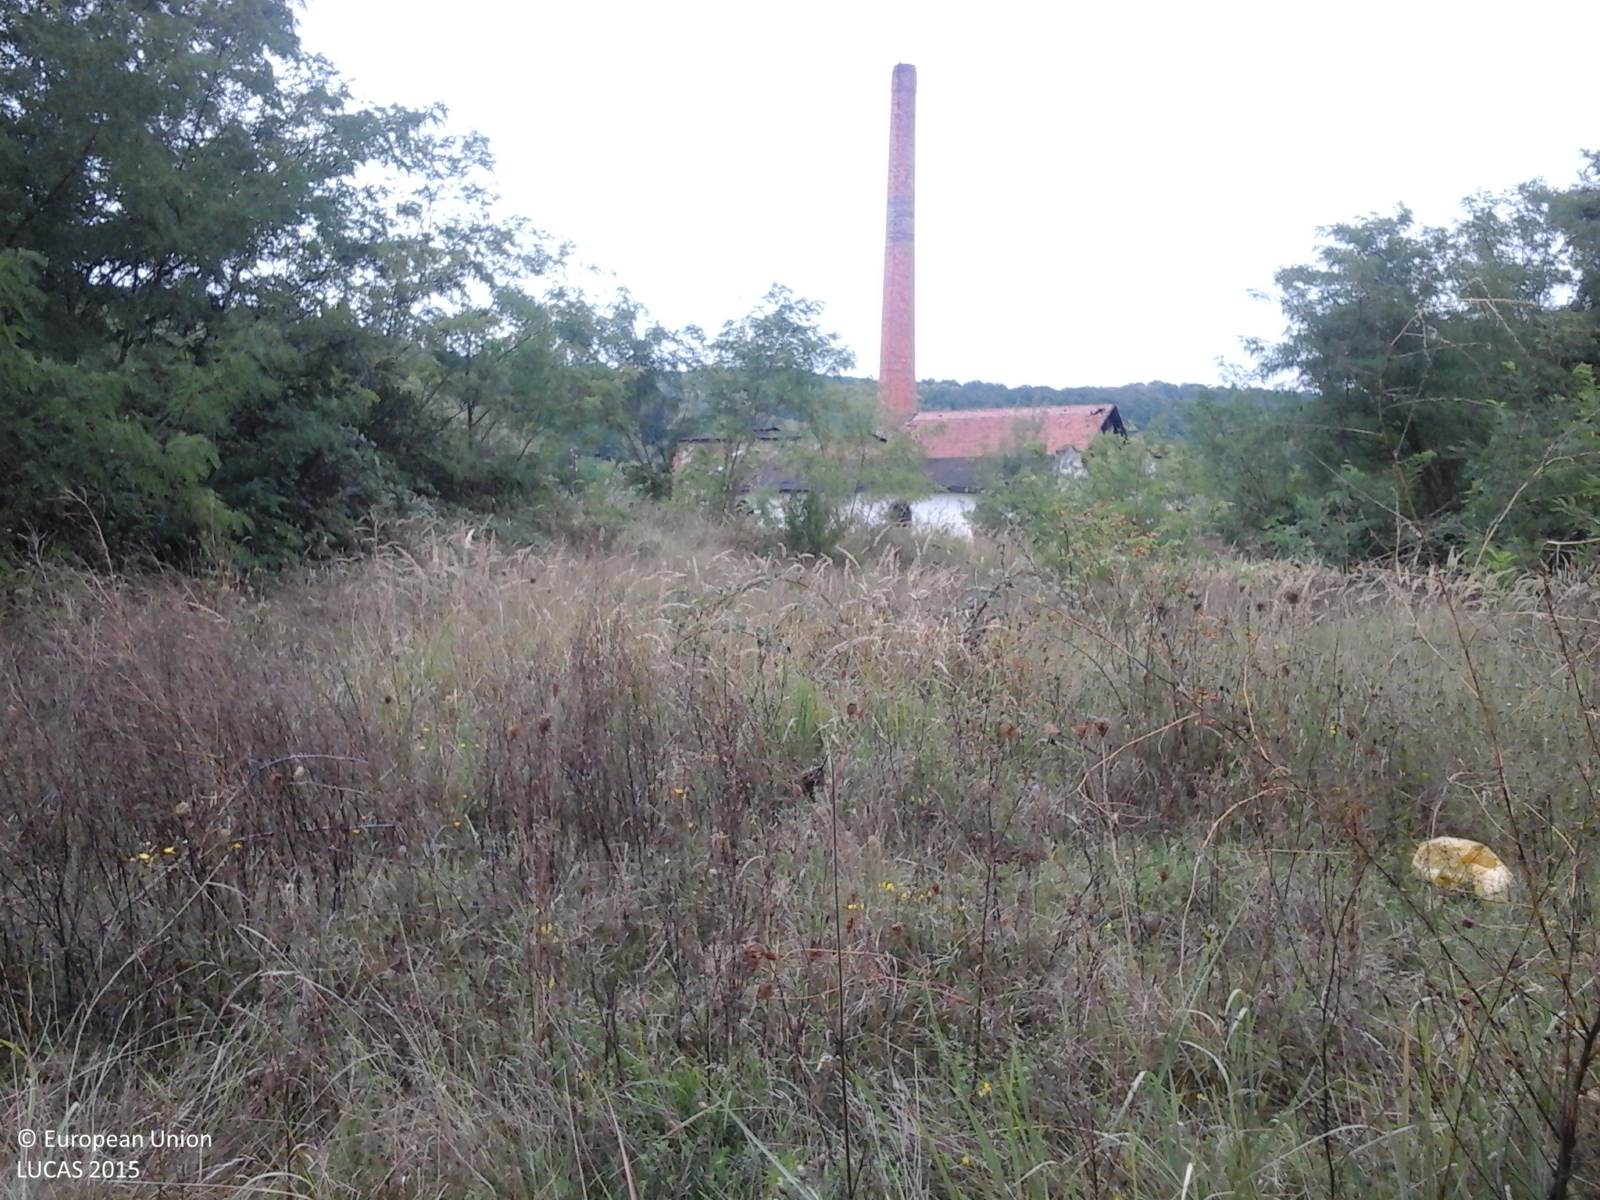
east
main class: Grassland
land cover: Grassland with sparse tree/shrub cover
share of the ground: > 75 %
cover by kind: herbaceous plants 85 %, shrubs 10 %, broadleaved forest trees 5 %
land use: Fallow land
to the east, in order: Grassland with sparse tree/shrub cover; Lines of trees; Inland fresh water bodies; Spontaneously vegetated surfaces; Ditches and canals; Grassland without tree/shrub cover; Tracks; Grassland without tree/shrub cover; Artificial constructions in urban areas; Shrubland with sparse tree cover; Tracks; Grass margins; Ditches and canals; Grassland without tree/shrub cover; Electric lines; Grassland without tree/shrub cover; Fences; Grass margins; Ditches and canals; Grass margins; Tracks; Grass margins; Ditches and canals; Grassland without tree/shrub cover; Electric lines; Spontaneously vegetated surfaces
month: September
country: RO
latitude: 47.2022
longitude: 22.3163
